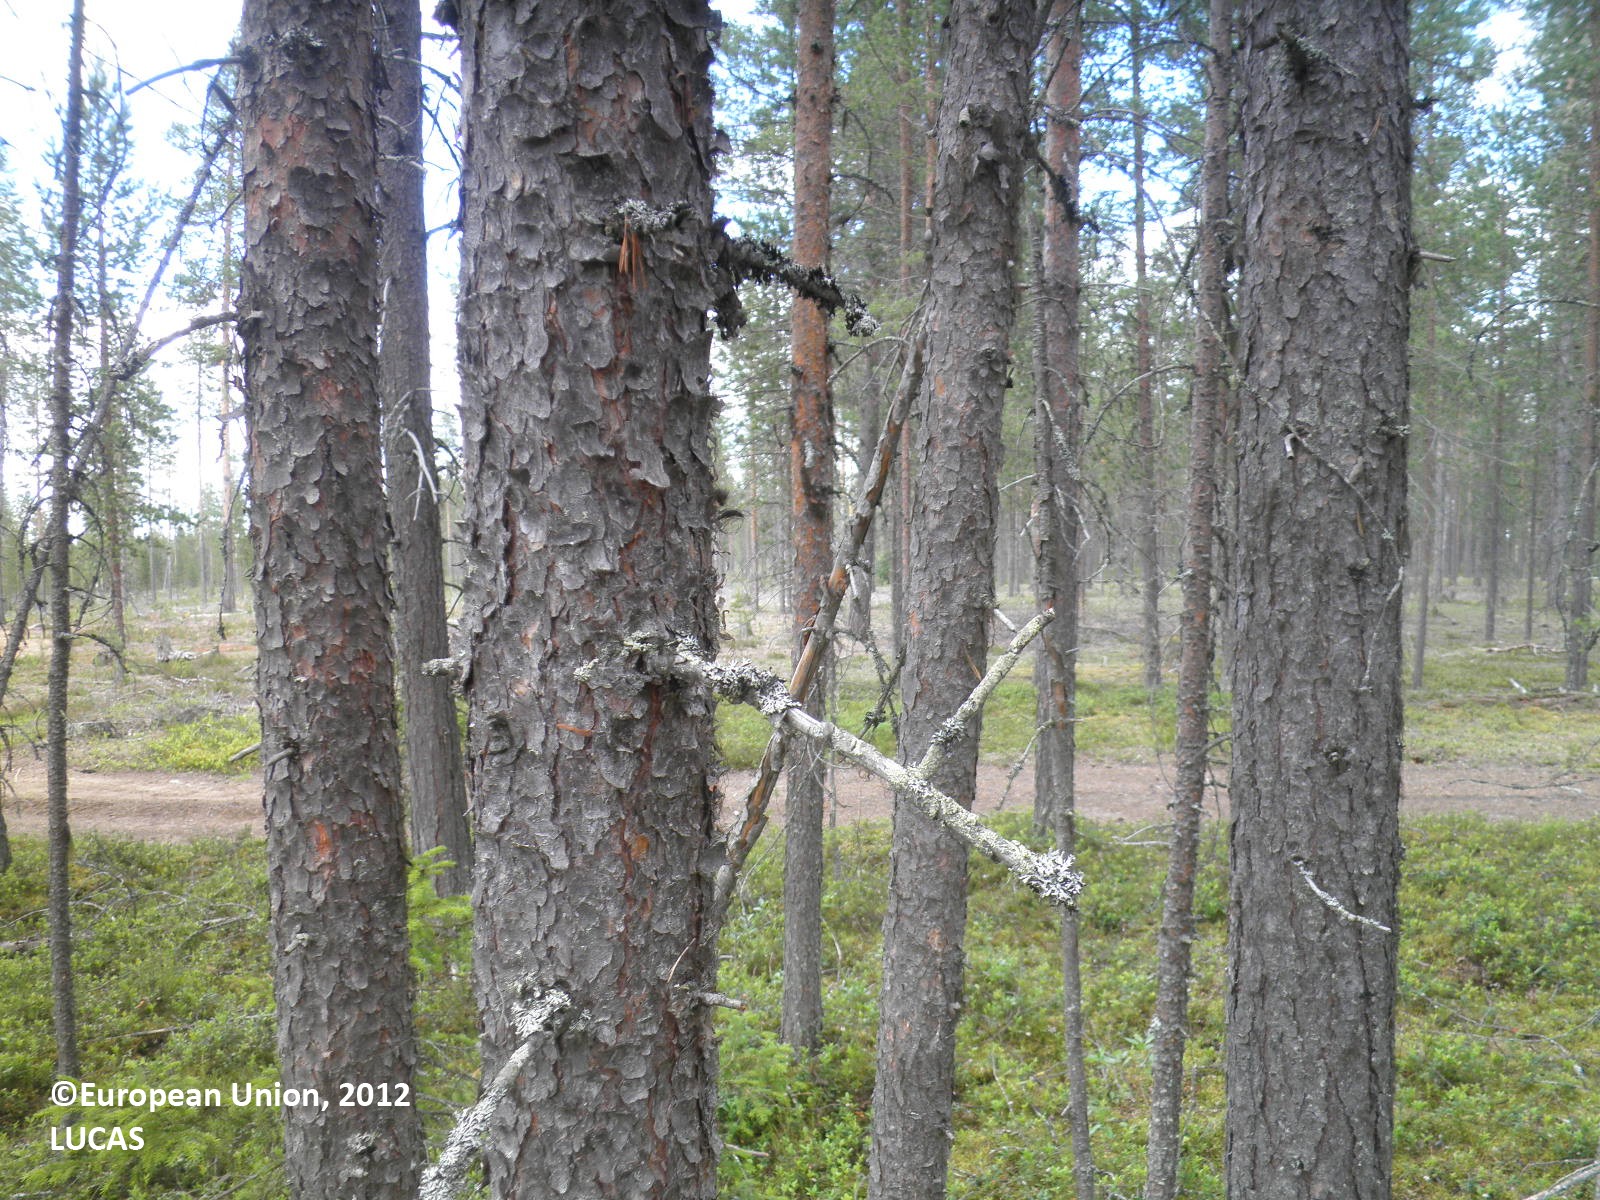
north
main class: Woodland
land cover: Pine dominated coniferous woodland
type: boreal forest
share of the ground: 50 - 75 %
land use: Forestry
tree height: > 5 m
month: July
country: FI
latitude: 67.5407
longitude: 25.8898
